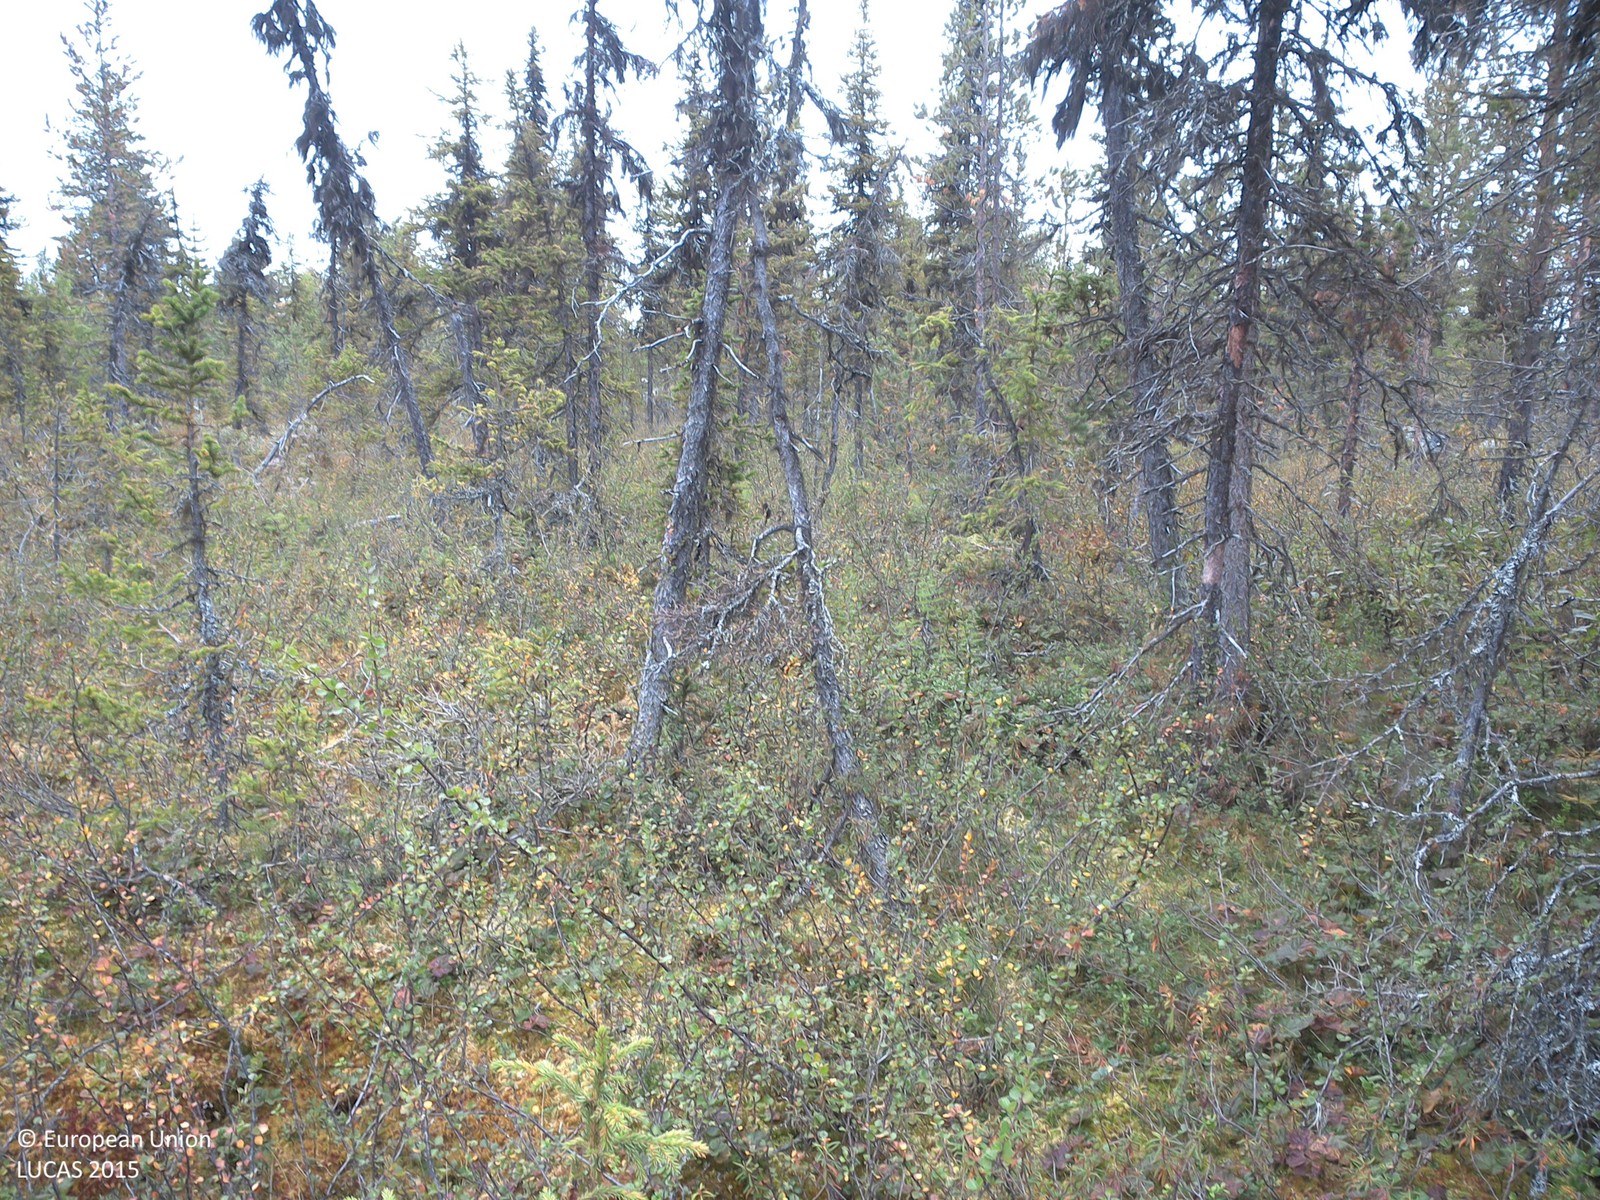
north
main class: Woodland
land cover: Spruce dominated coniferous woodland
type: boreal forest
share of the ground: 10 - 25 %
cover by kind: shrubs 60 %, coniferous forest trees 20 %, lichens and mosses 20 %
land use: Forestry
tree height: > 5 m
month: August
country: SE
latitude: 67.8295
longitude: 21.4618
